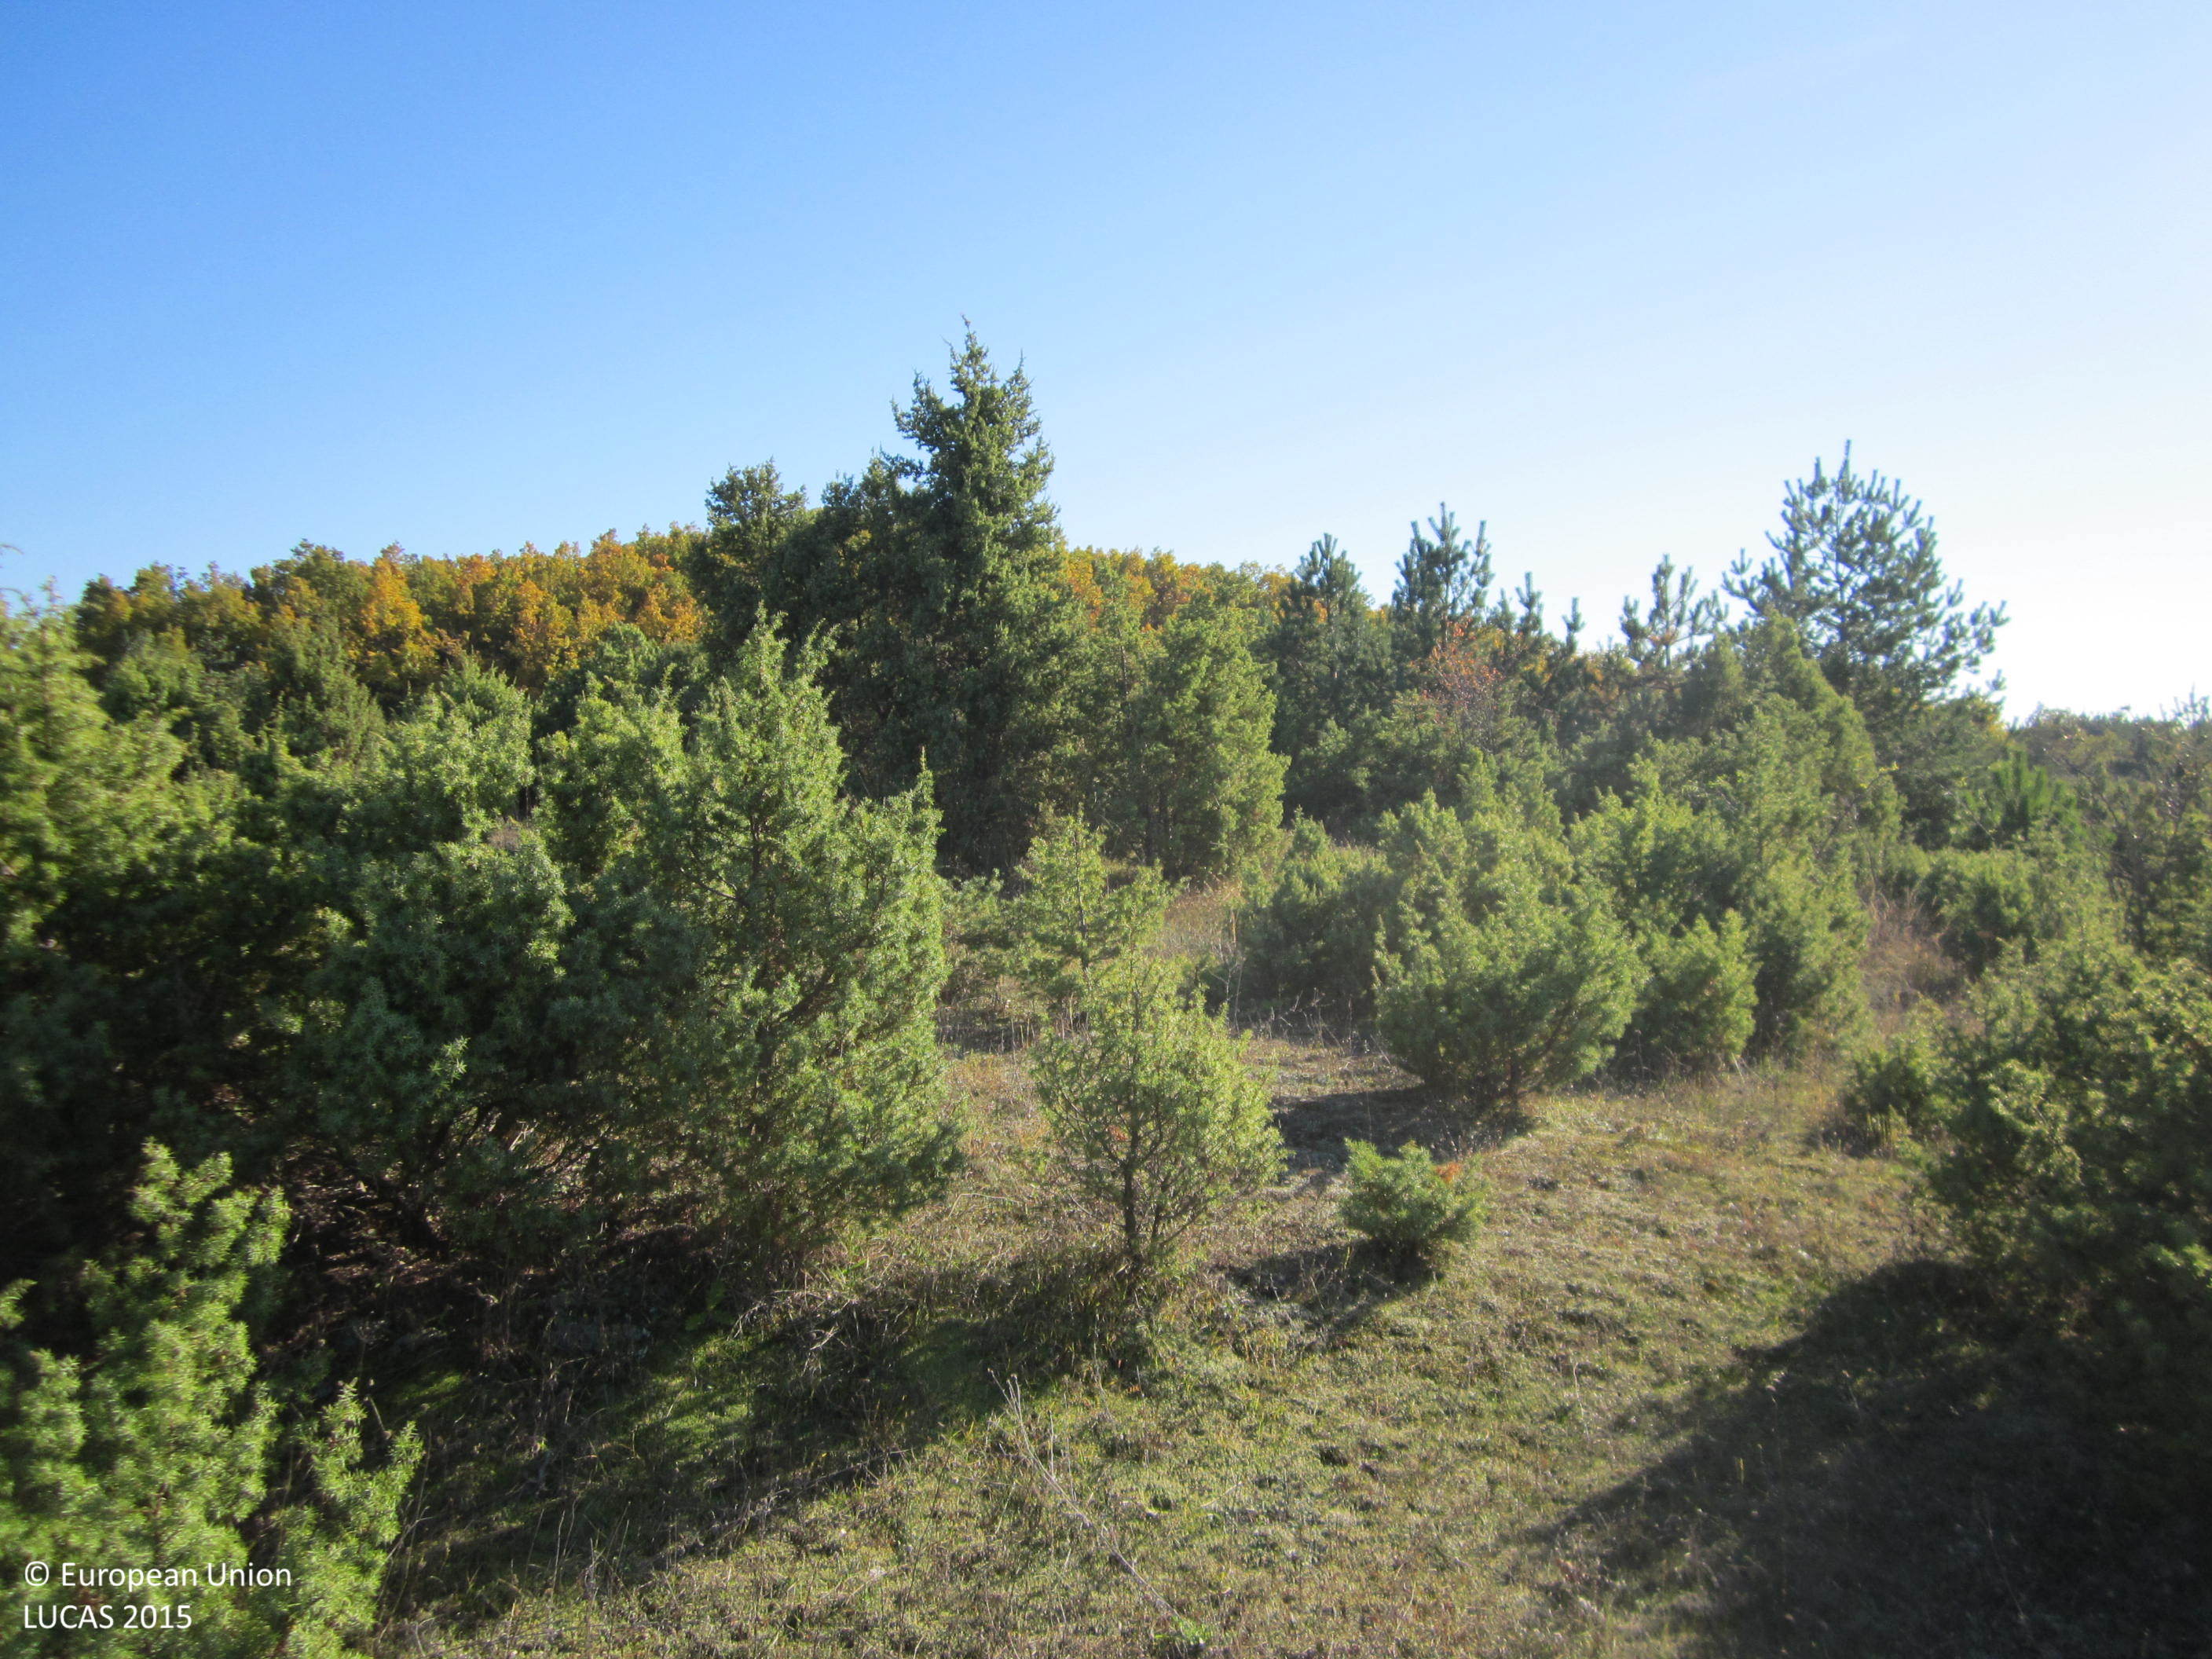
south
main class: Woodland
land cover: Other coniferous woodland
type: hemiboreal forest and nemoral coniferous forest and mixed broadleaved-coniferous forest
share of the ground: 50 - 75 %
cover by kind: coniferous forest trees 60 %, herbaceous plants 35 %, broadleaved forest trees 5 %
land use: Agriculture (excluding fallow land and kitchen gardens)
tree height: < 5 m
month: November
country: BG
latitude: 41.4135
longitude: 25.7455
